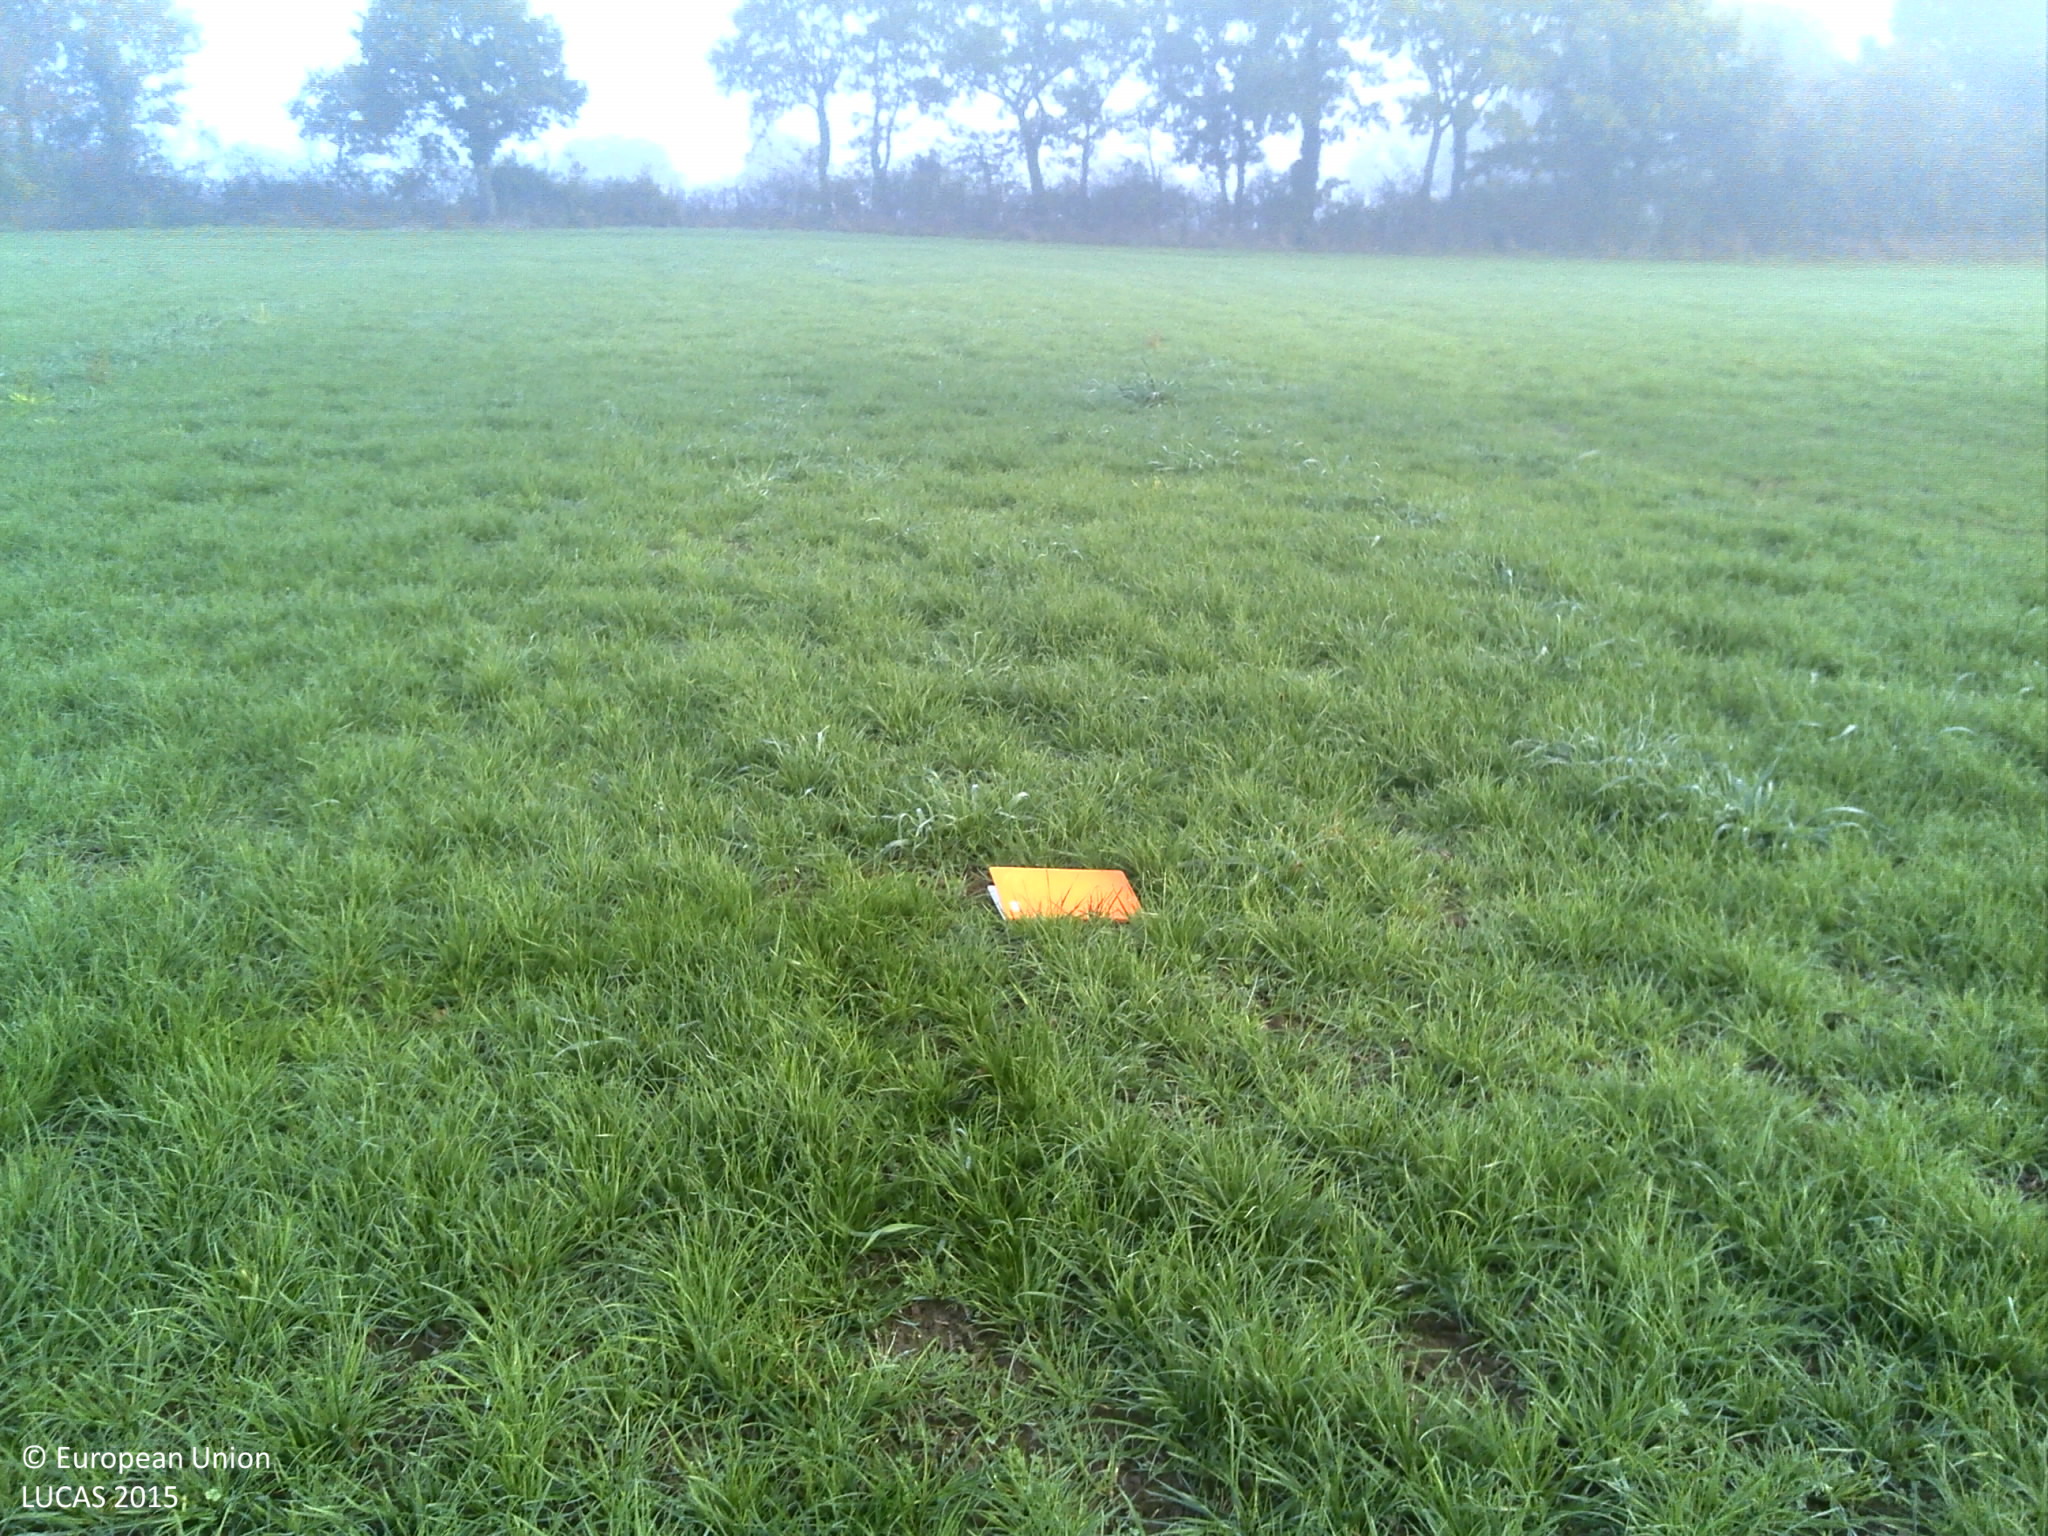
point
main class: Grassland
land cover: Grassland without tree/shrub cover
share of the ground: > 75 %
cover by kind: herbaceous plants 100 %
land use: Agriculture (excluding fallow land and kitchen gardens)
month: November
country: FR
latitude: 47.4038
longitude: -1.4777
